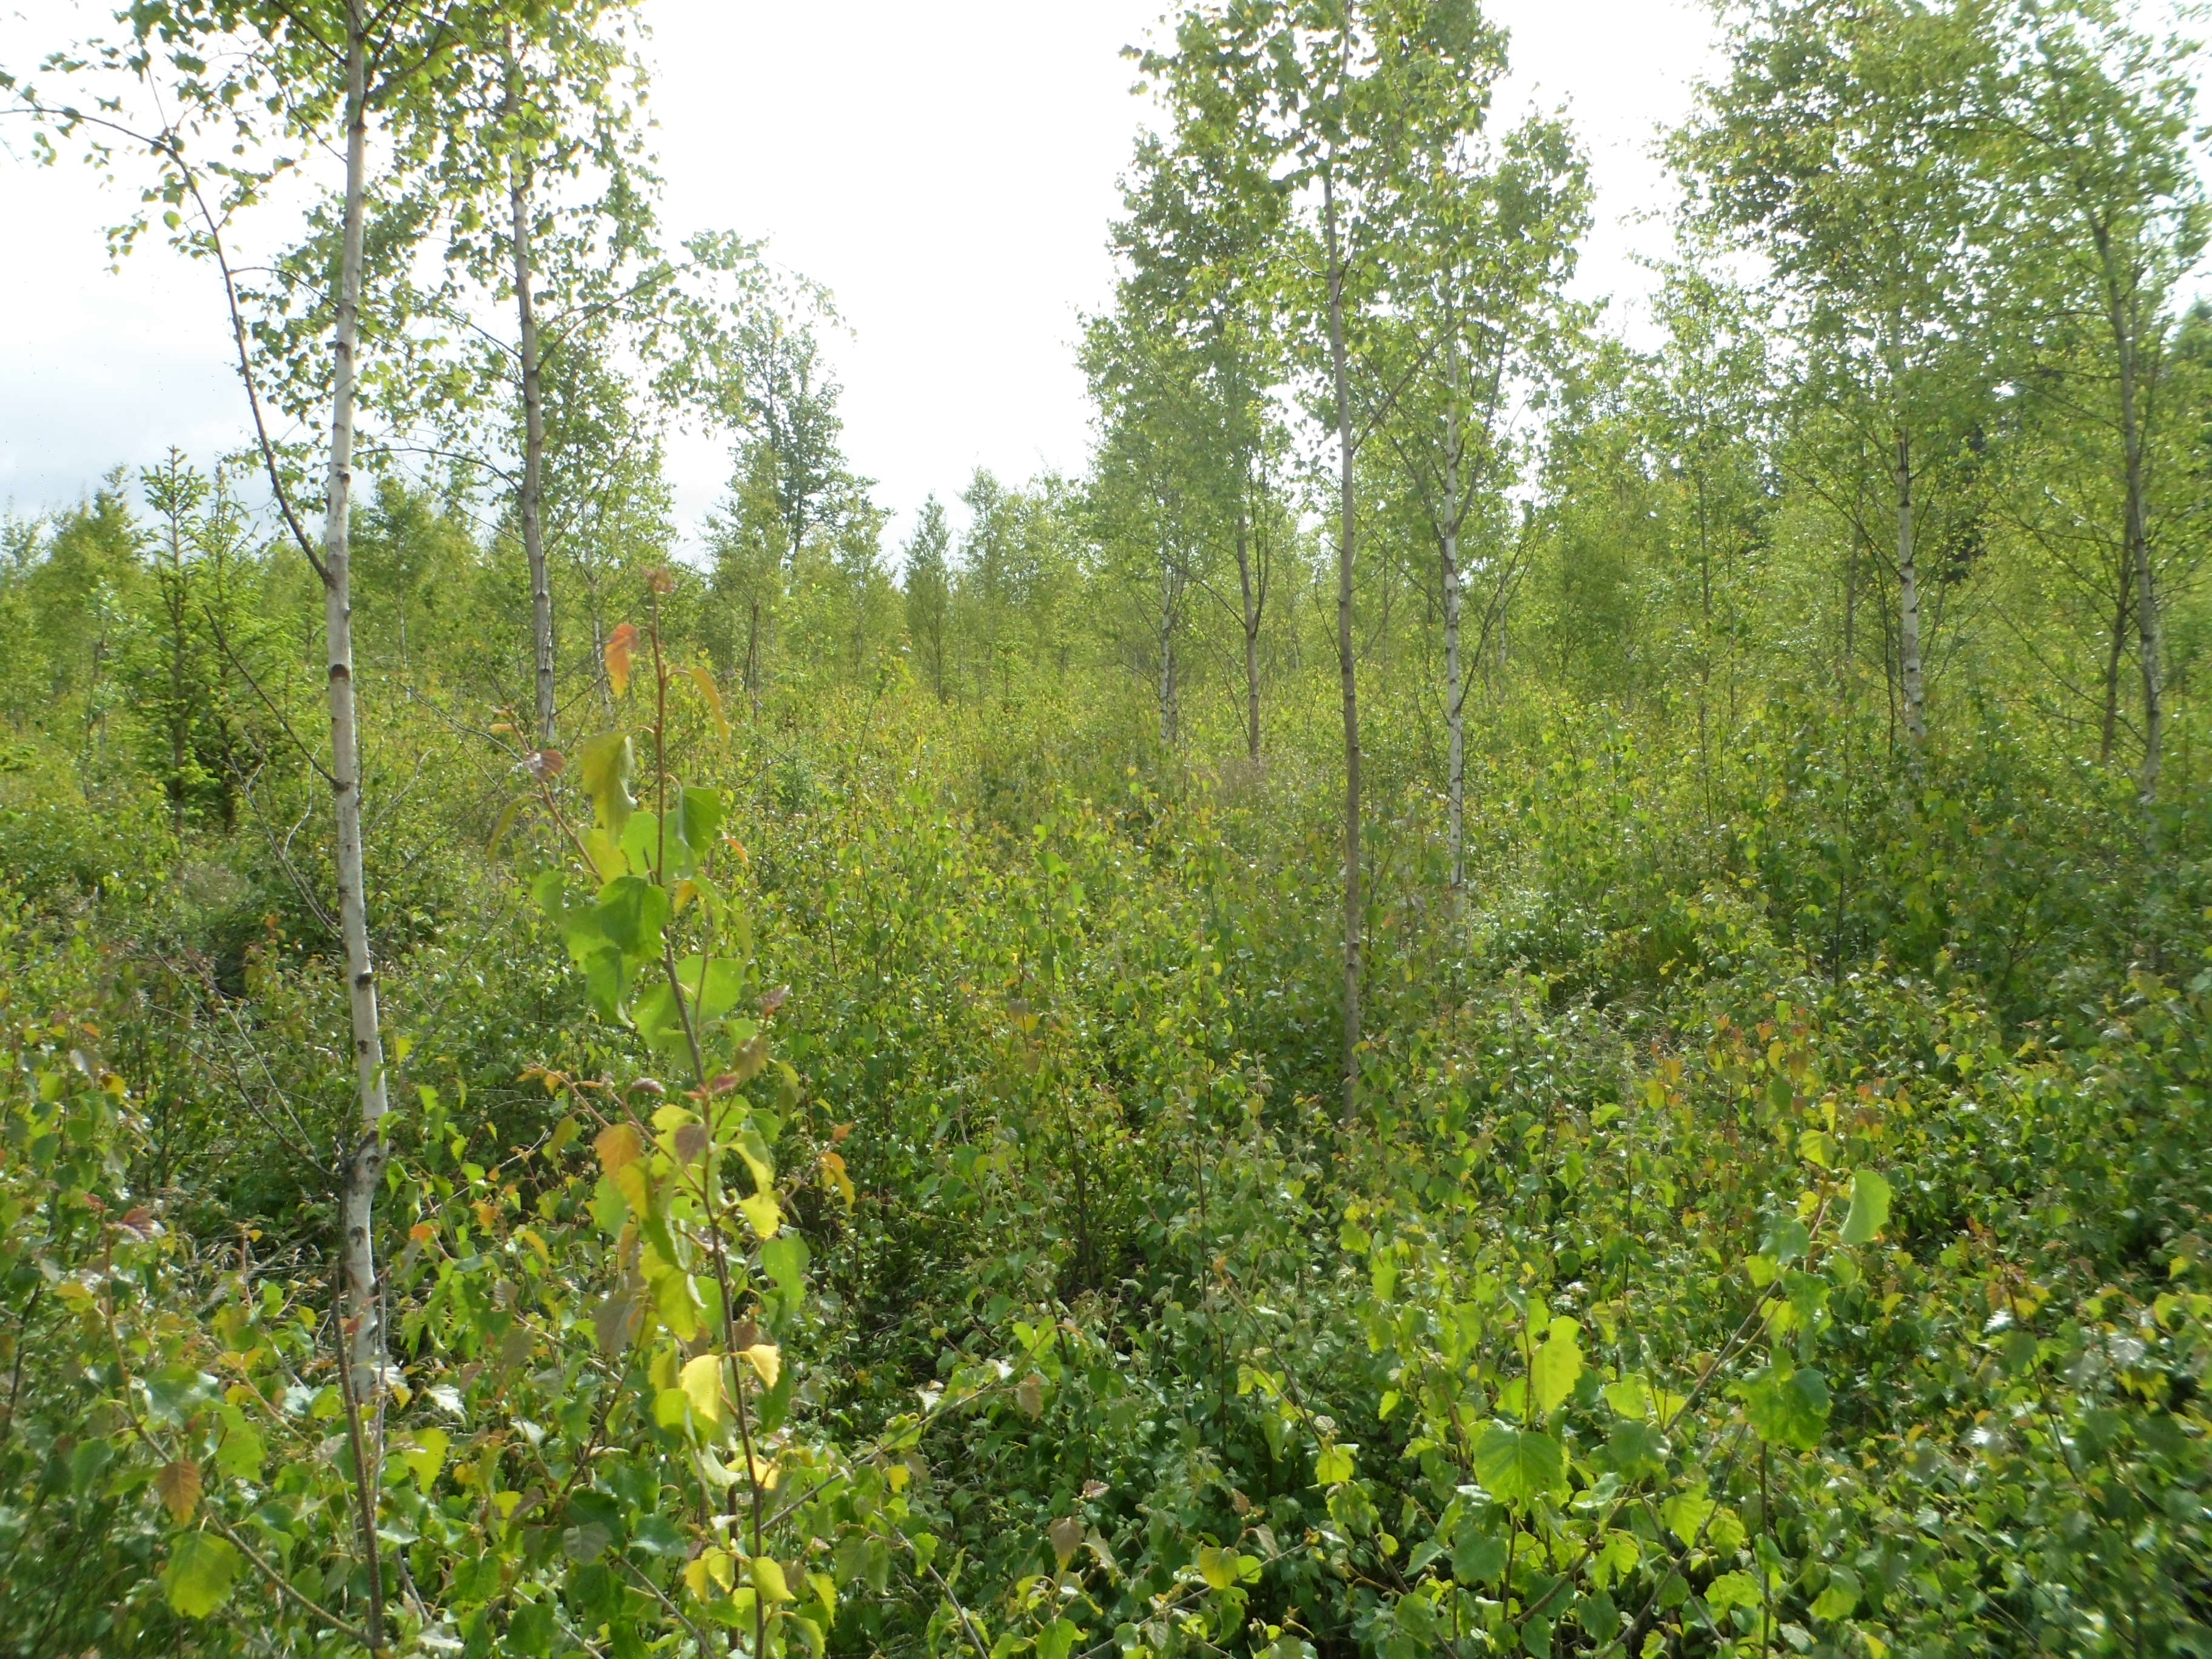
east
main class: Woodland
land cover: Broadleaved woodland
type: boreal forest
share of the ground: > 75 %
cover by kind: broadleaved forest trees 70 %, herbaceous plants 15 %, coniferous forest trees 10 %, shrubs 5 %
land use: Forestry
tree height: < 5 m
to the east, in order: Broadleaved woodland; Spruce dominated mixed woodland; Broadleaved woodland; Spruce dominated mixed woodland; Tracks; Spruce dominated mixed woodland
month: June
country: SE
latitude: 56.9322
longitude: 14.6473
